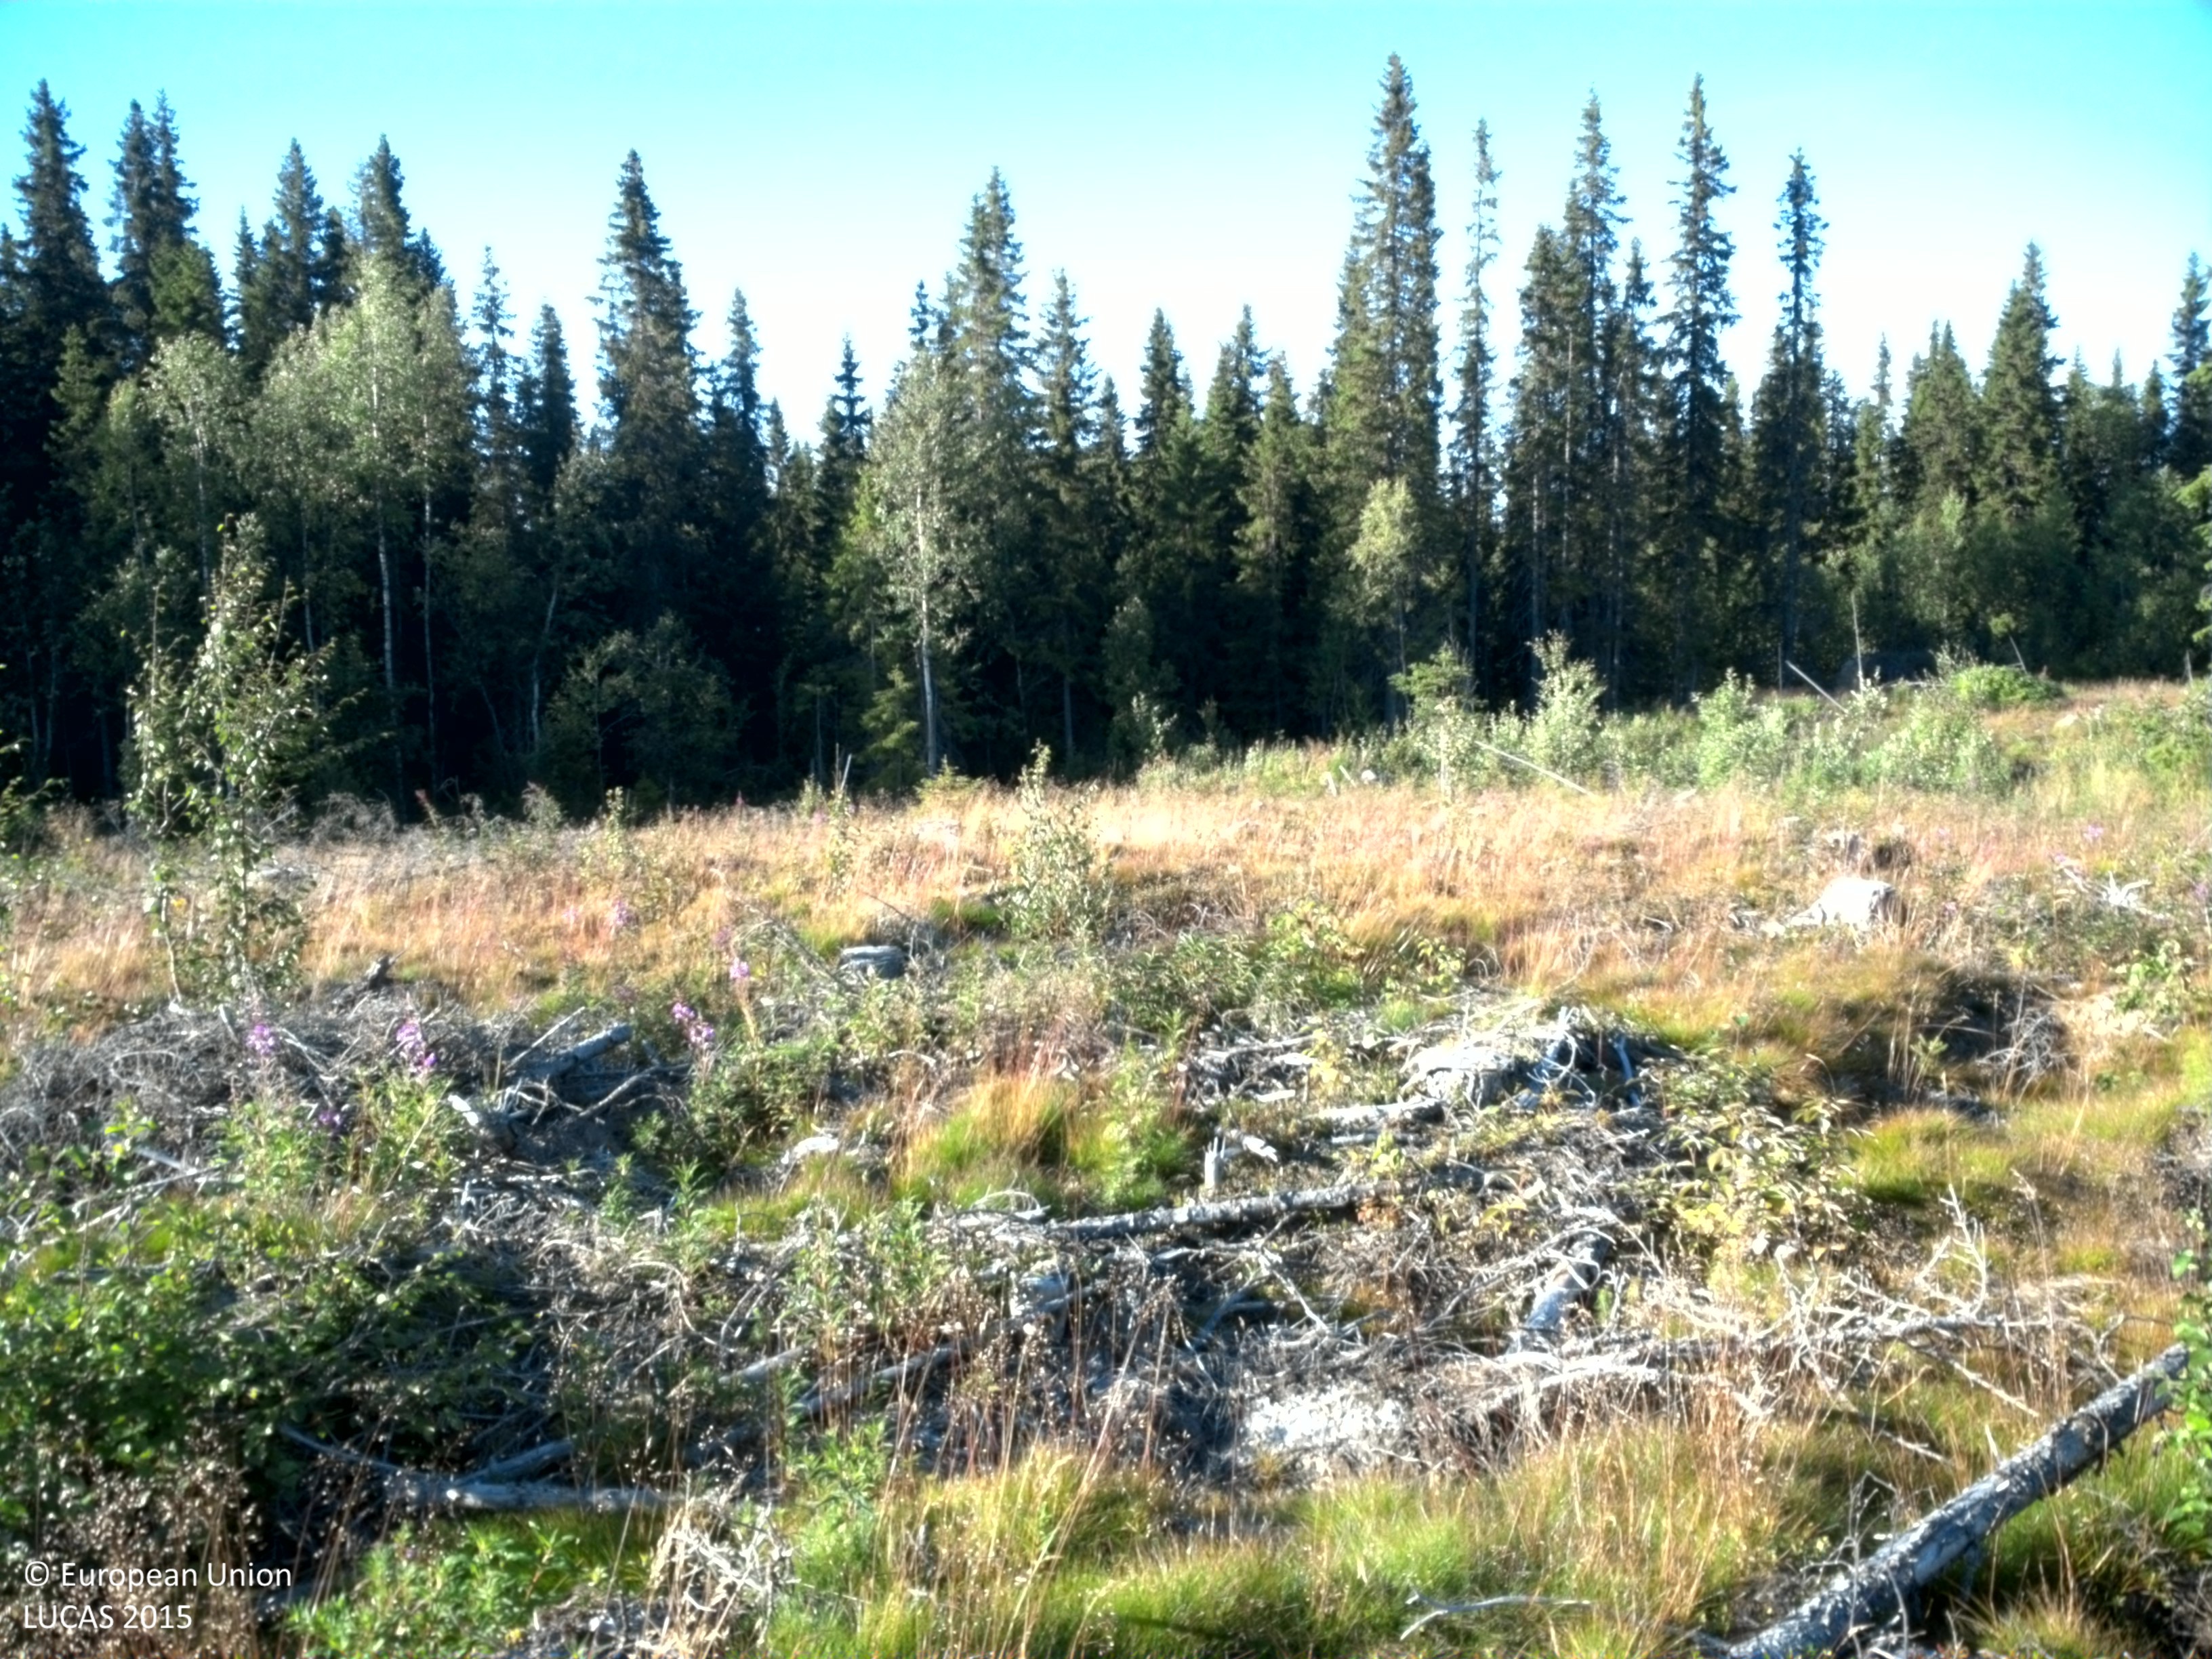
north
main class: Grassland
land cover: Grassland with sparse tree/shrub cover
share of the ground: > 75 %
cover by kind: herbaceous plants 85 %, broadleaved forest trees 5 %, shrubs 5 %, lichens and mosses 5 %
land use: Forestry
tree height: < 5 m
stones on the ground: < 10 %
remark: Clear cut
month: August
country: SE
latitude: 64.6760
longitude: 16.1905
